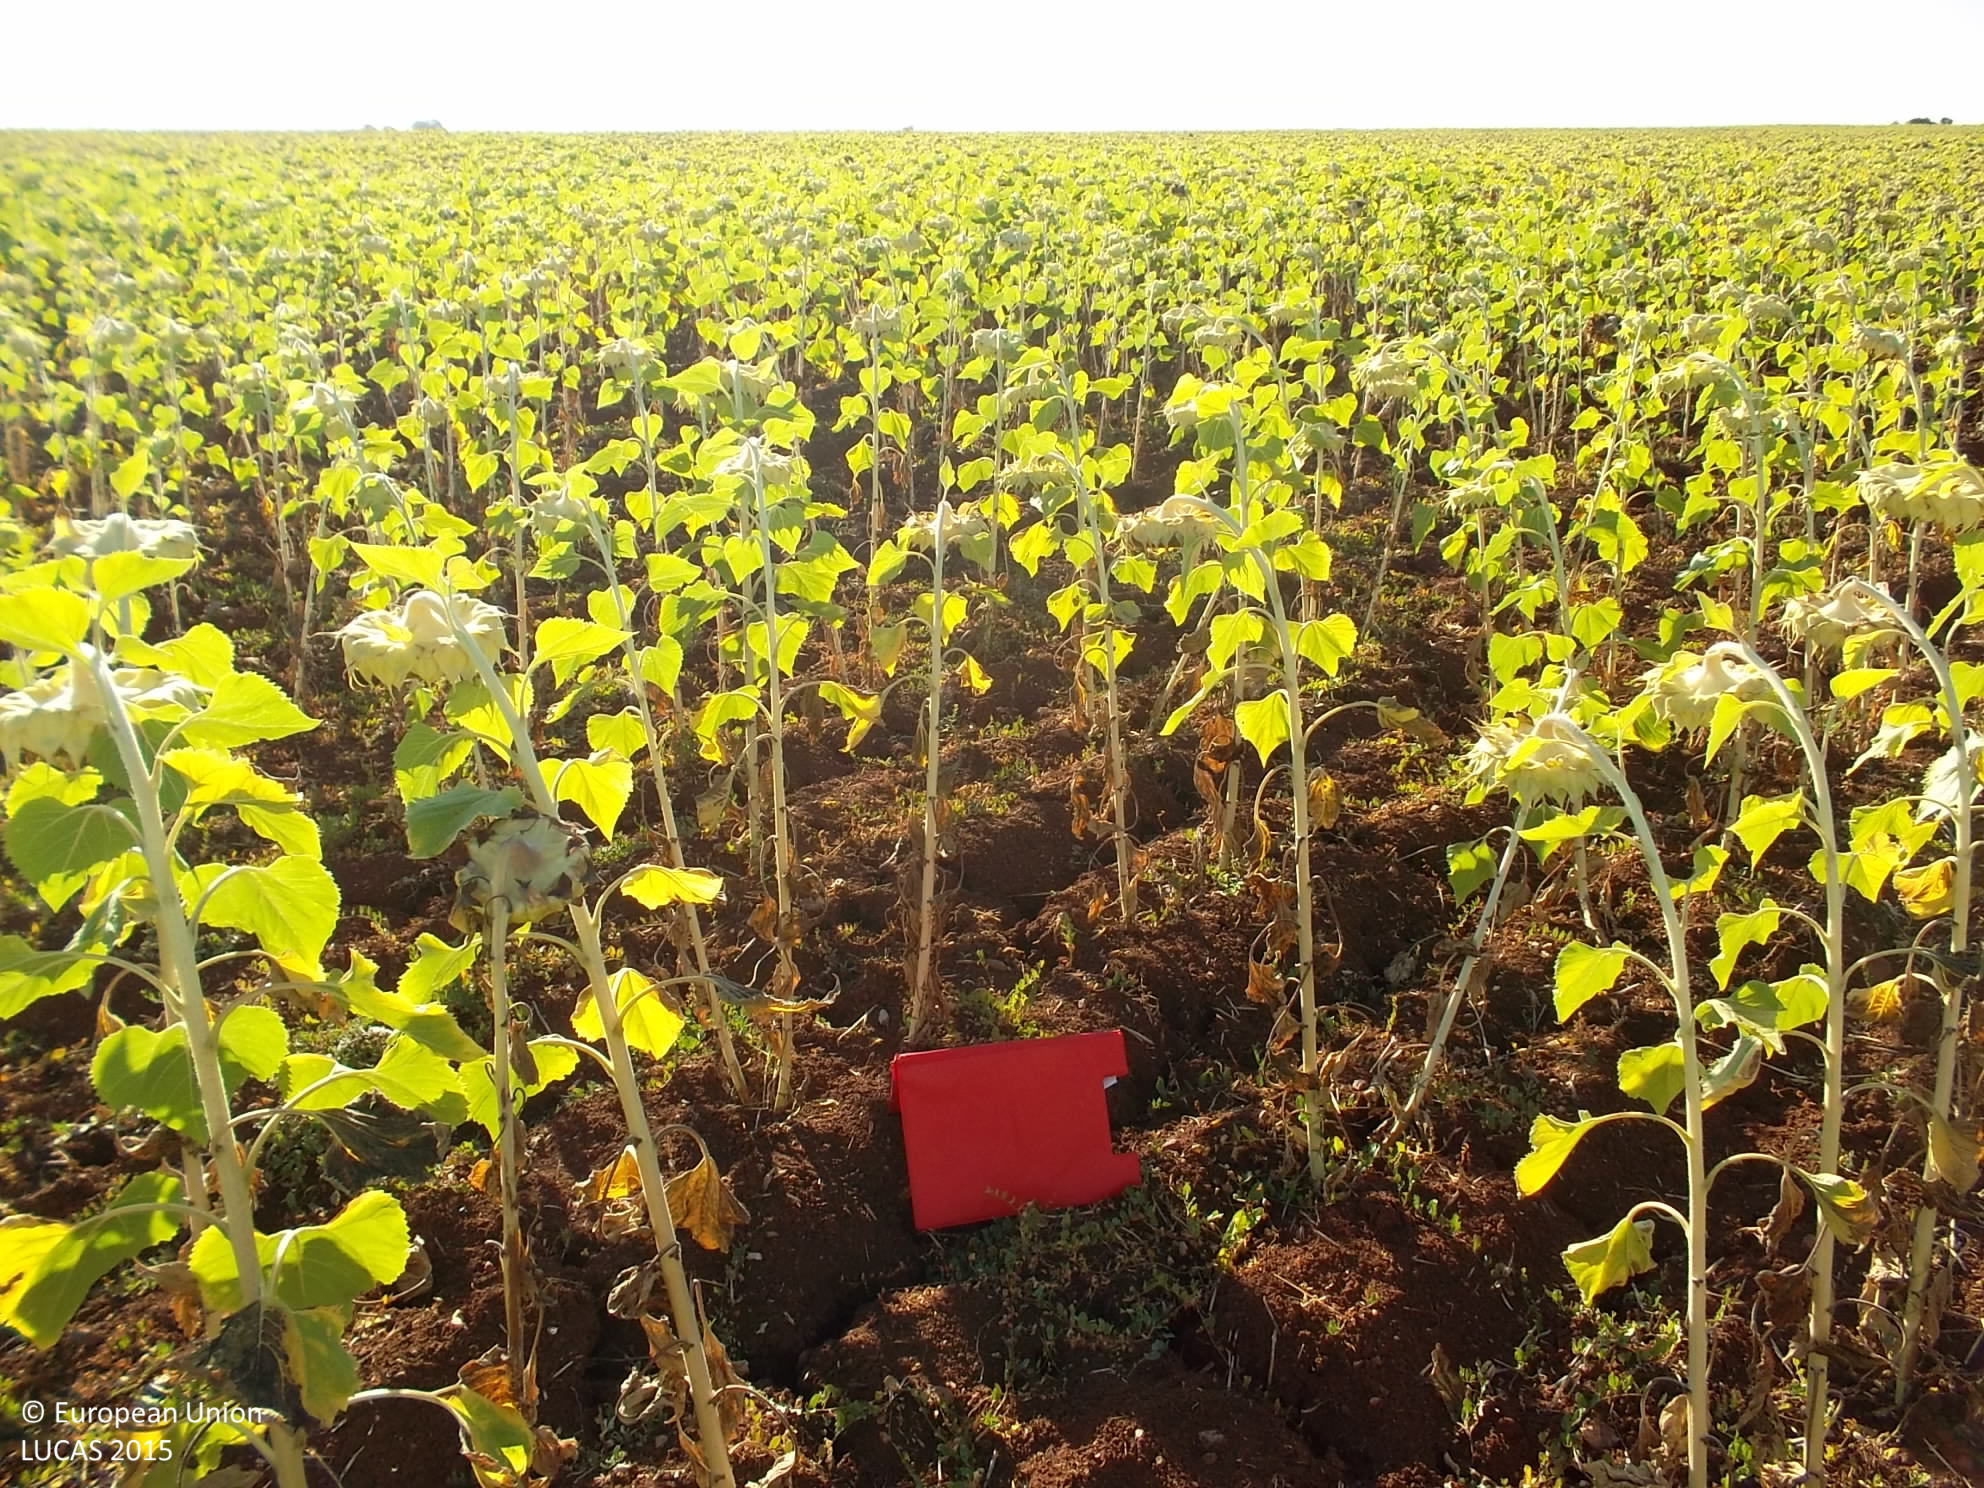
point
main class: Cropland
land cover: Sunflower
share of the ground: > 75 %
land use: Agriculture (excluding fallow land and kitchen gardens)
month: July
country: ES
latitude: 38.3465
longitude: -5.7236
